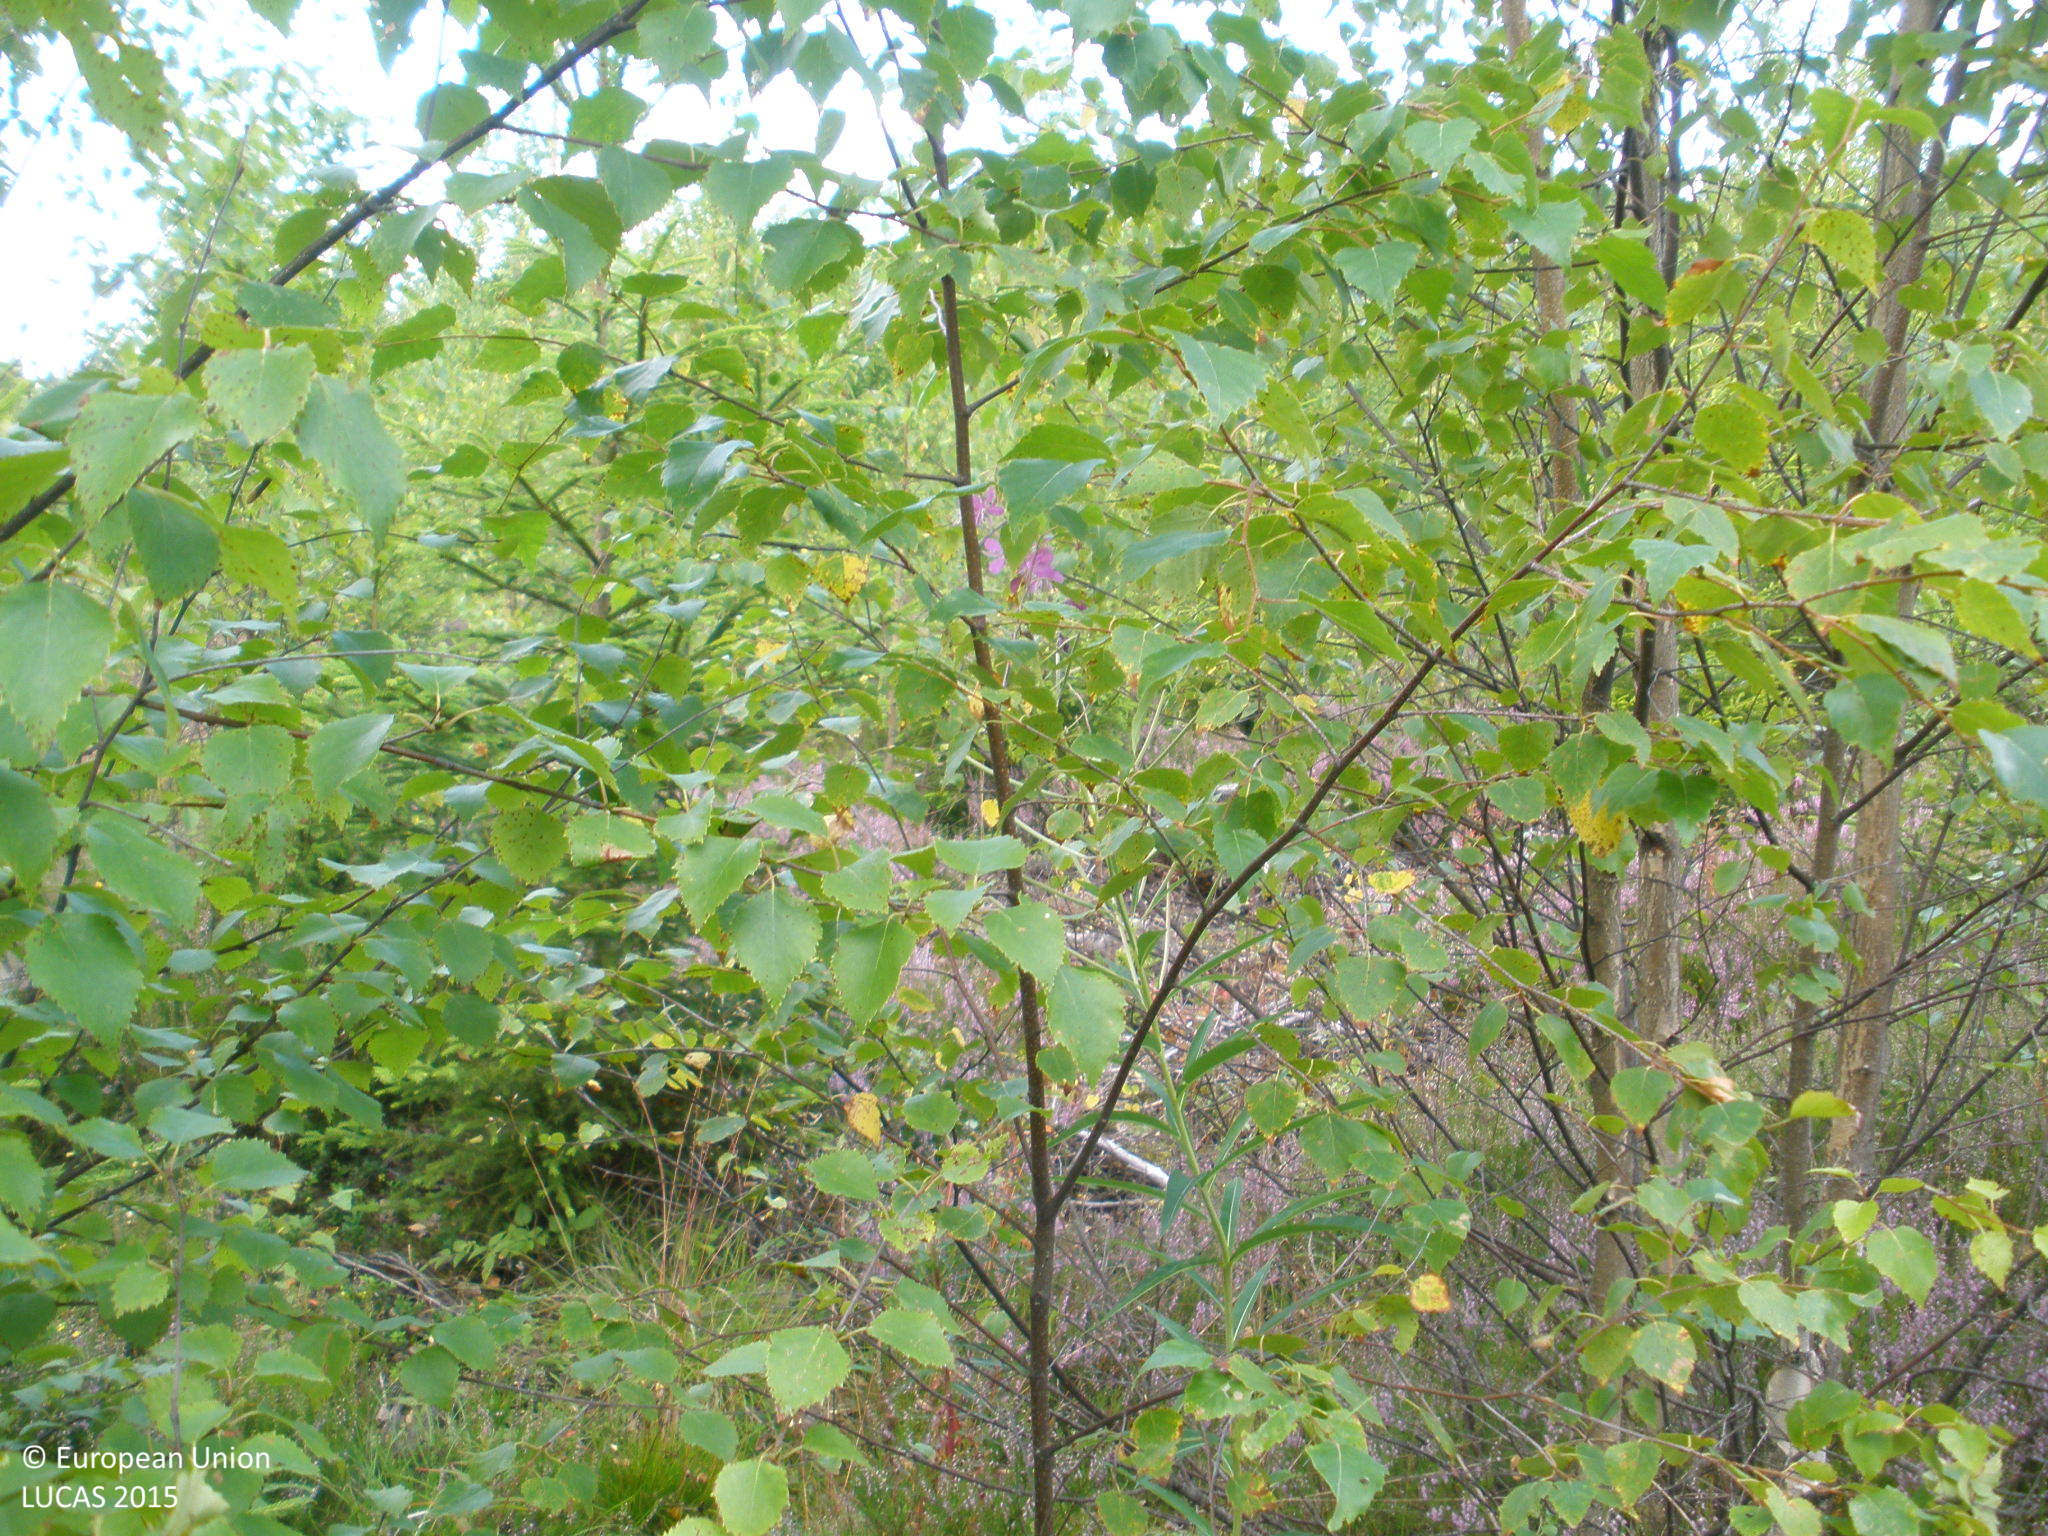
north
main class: Woodland
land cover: Spruce dominated mixed woodland
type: boreal forest
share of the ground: 50 - 75 %
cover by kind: broadleaved forest trees 35 %, coniferous forest trees 25 %, shrubs 20 %, herbaceous plants 20 %
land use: Forestry
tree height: < 5 m
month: August
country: FI
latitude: 60.7335
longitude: 24.2748
